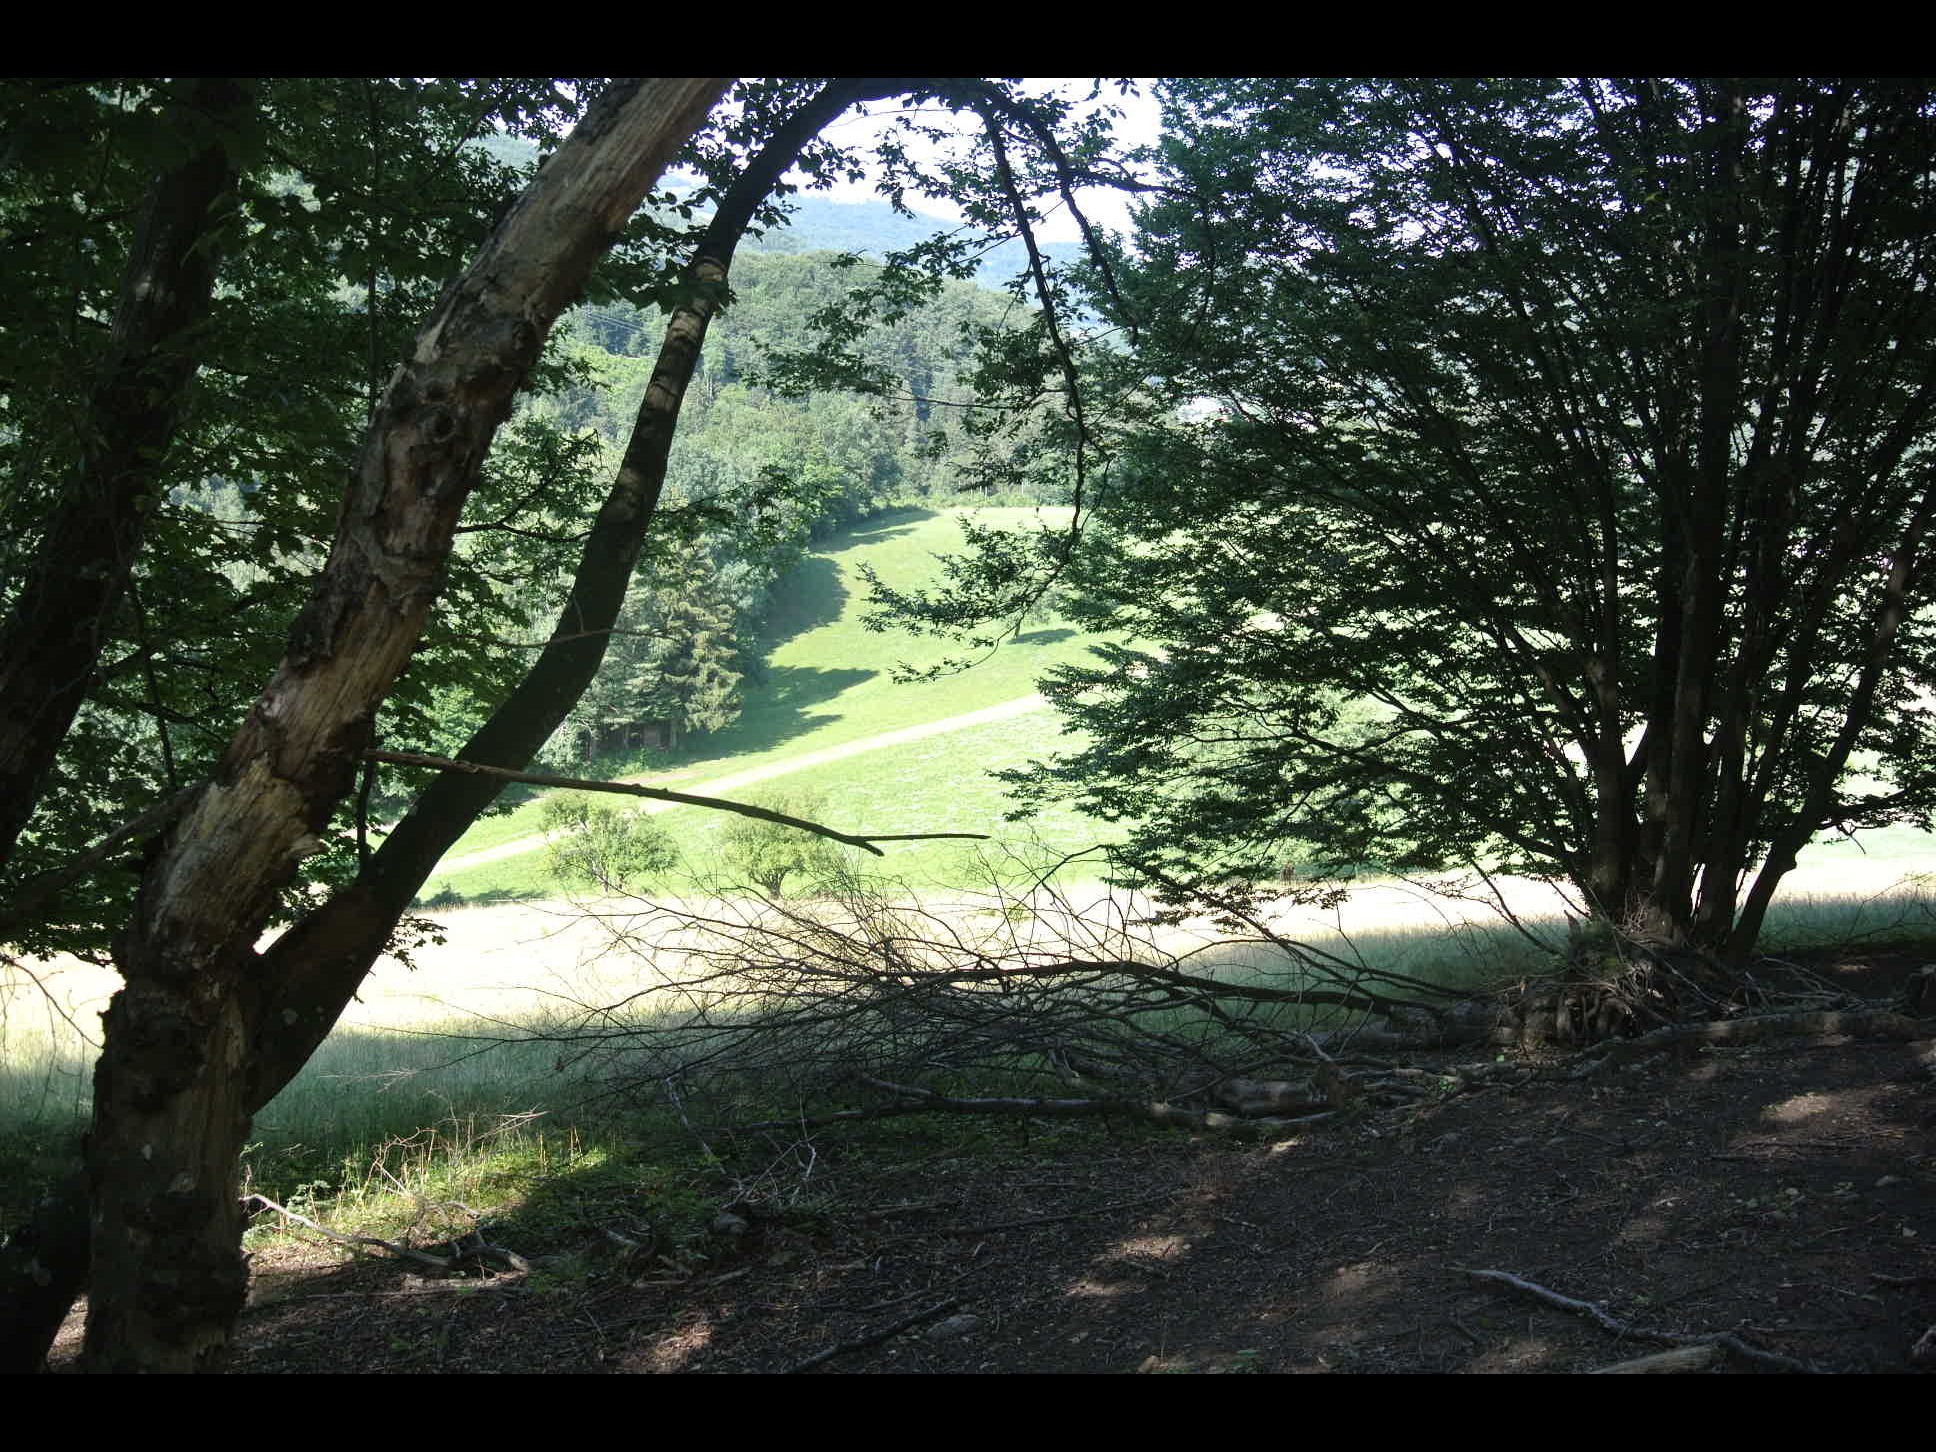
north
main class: Woodland
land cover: Broadleaved woodland
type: alpine coniferous forest
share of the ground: > 75 %
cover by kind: broadleaved forest trees 90 %, unconsolidated bare surface 10 %
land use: Forestry
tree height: > 5 m
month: July
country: AT
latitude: 47.9929
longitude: 15.5634
